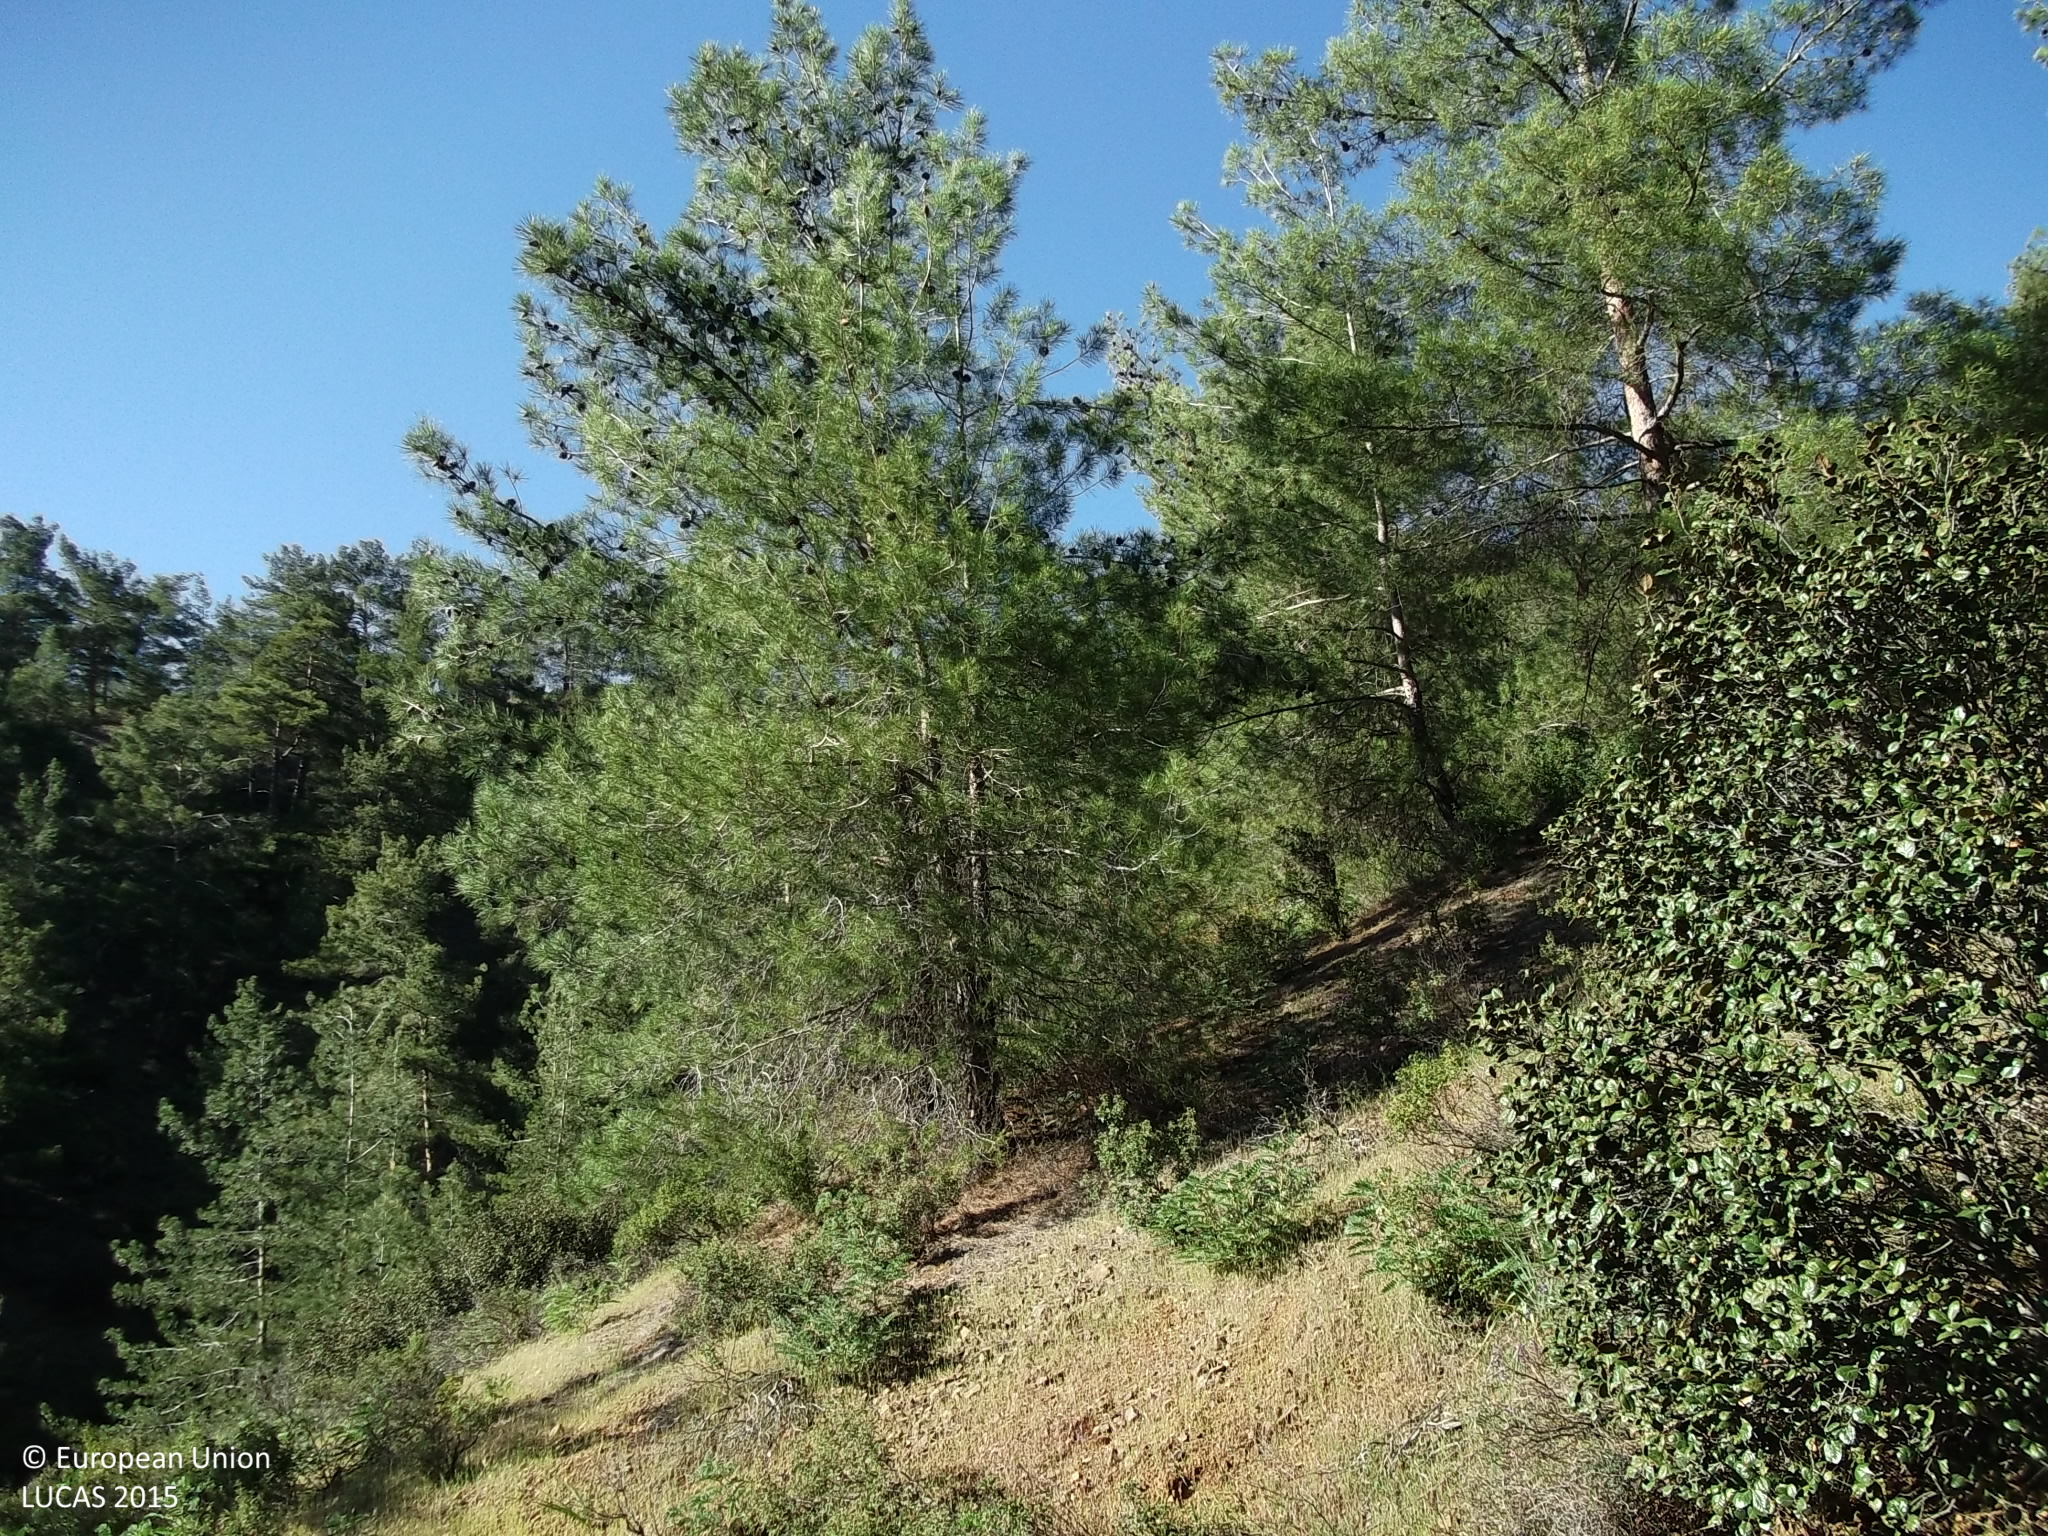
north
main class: Woodland
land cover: Pine dominated coniferous woodland
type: coniferous forest of the mediterranean region
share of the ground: 50 - 75 %
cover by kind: coniferous forest trees 55 %, shrubs 15 %, herbaceous plants 10 %, consolidated bare surface 10 %, unconsolidated bare surface 10 %
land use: Semi-natural and natural areas not in use
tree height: > 5 m
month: April
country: CY
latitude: 34.9287
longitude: 33.1331
